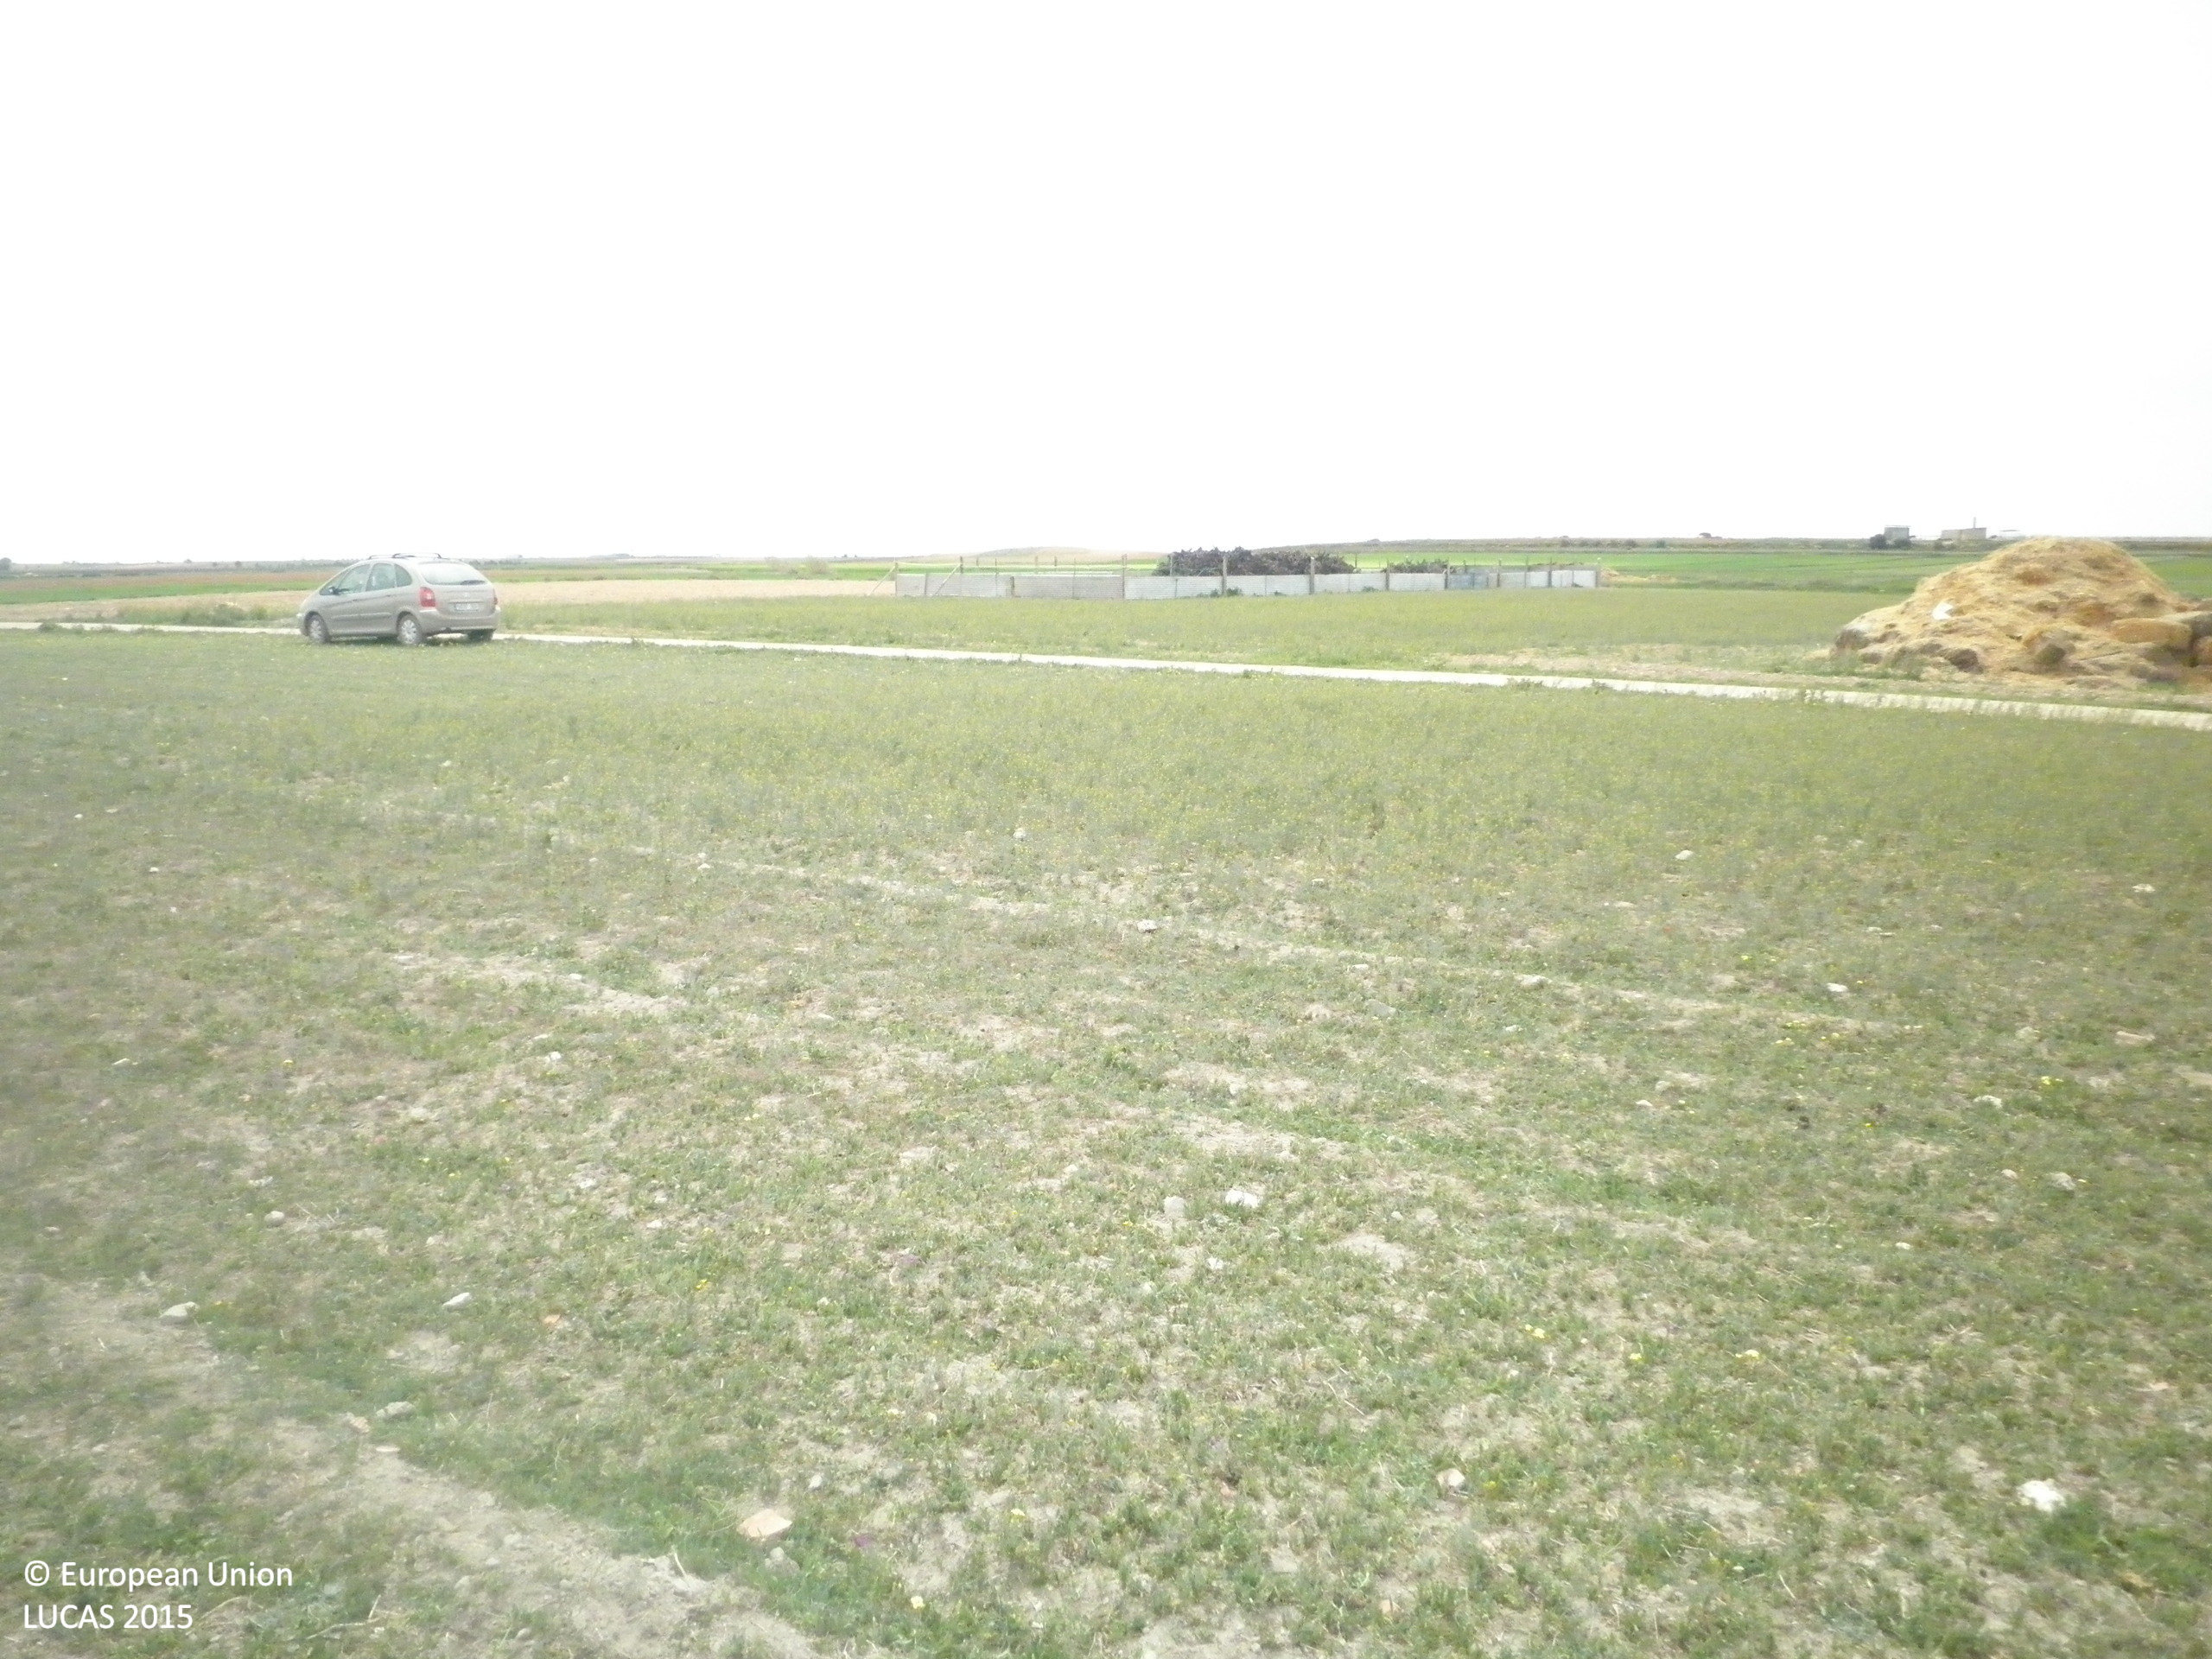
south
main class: Grassland
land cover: Grassland without tree/shrub cover
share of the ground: 50 - 75 %
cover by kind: herbaceous plants 60 %, unconsolidated bare surface 40 %
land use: Agriculture (excluding fallow land and kitchen gardens)
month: April
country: ES
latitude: 39.3950
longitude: -2.7510
